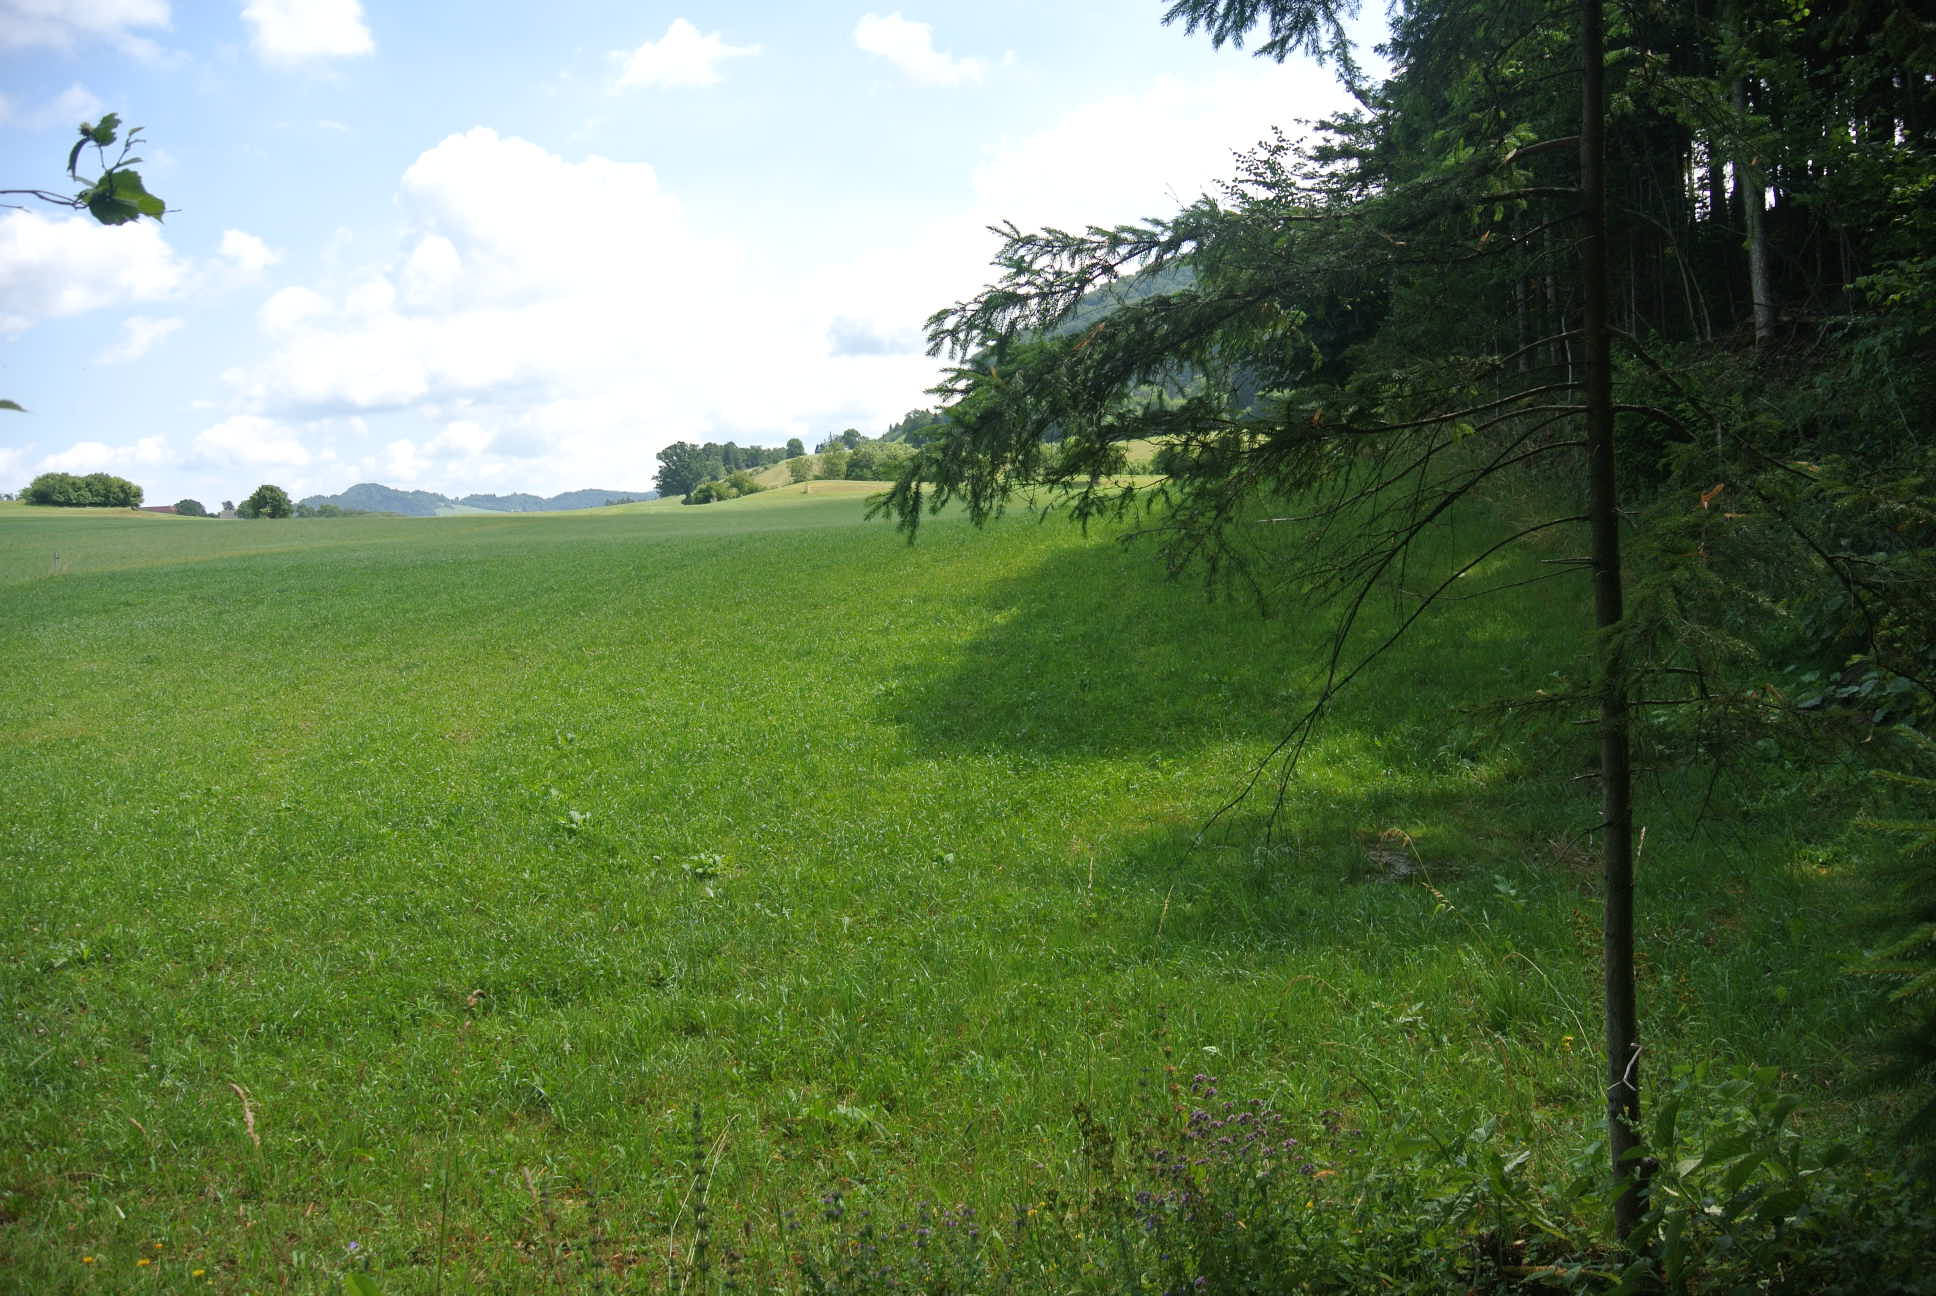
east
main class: Woodland
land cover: Spruce dominated mixed woodland
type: alpine coniferous forest
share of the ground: > 75 %
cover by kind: coniferous forest trees 60 %, broadleaved forest trees 40 %
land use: Forestry
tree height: > 5 m
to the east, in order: Spruce dominated mixed woodland; Grassland without tree/shrub cover
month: July
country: AT
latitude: 48.0162
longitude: 15.4584
